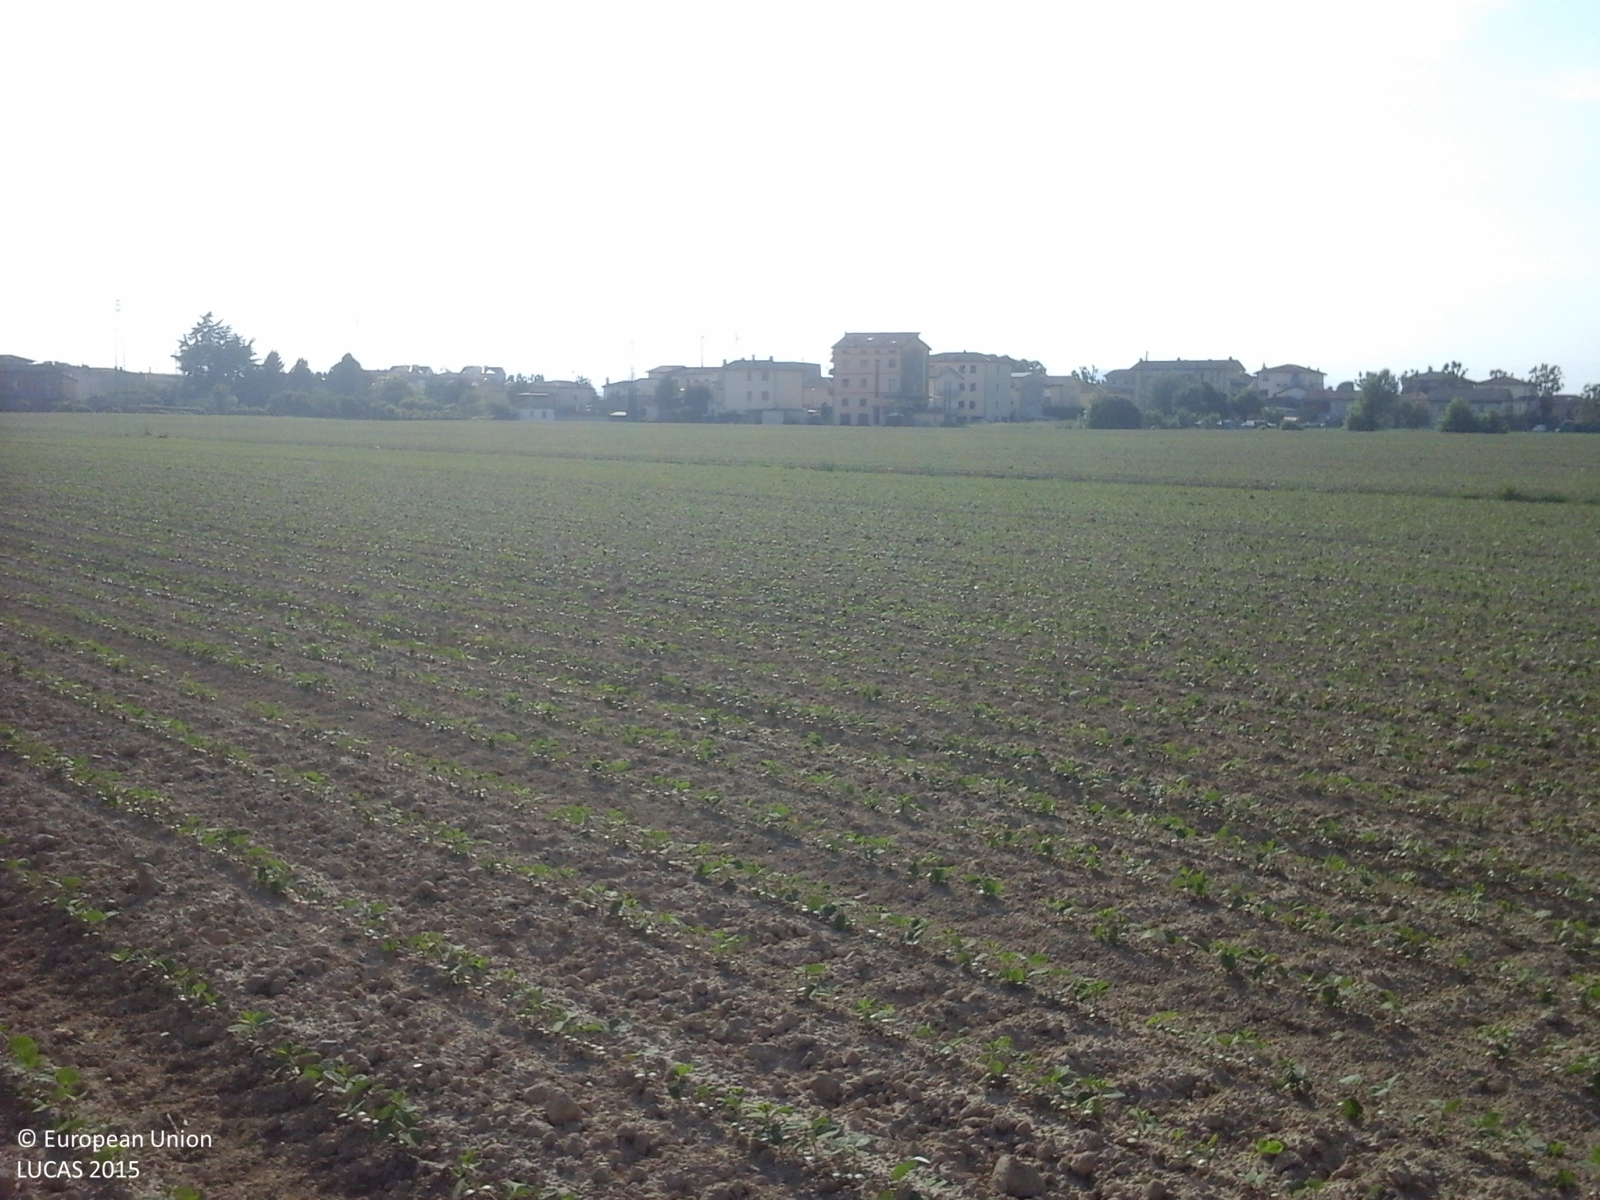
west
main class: Cropland
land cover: Soya
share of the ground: < 10 %
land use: Agriculture (excluding fallow land and kitchen gardens)
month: May
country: IT
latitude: 45.5648
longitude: 11.5734
